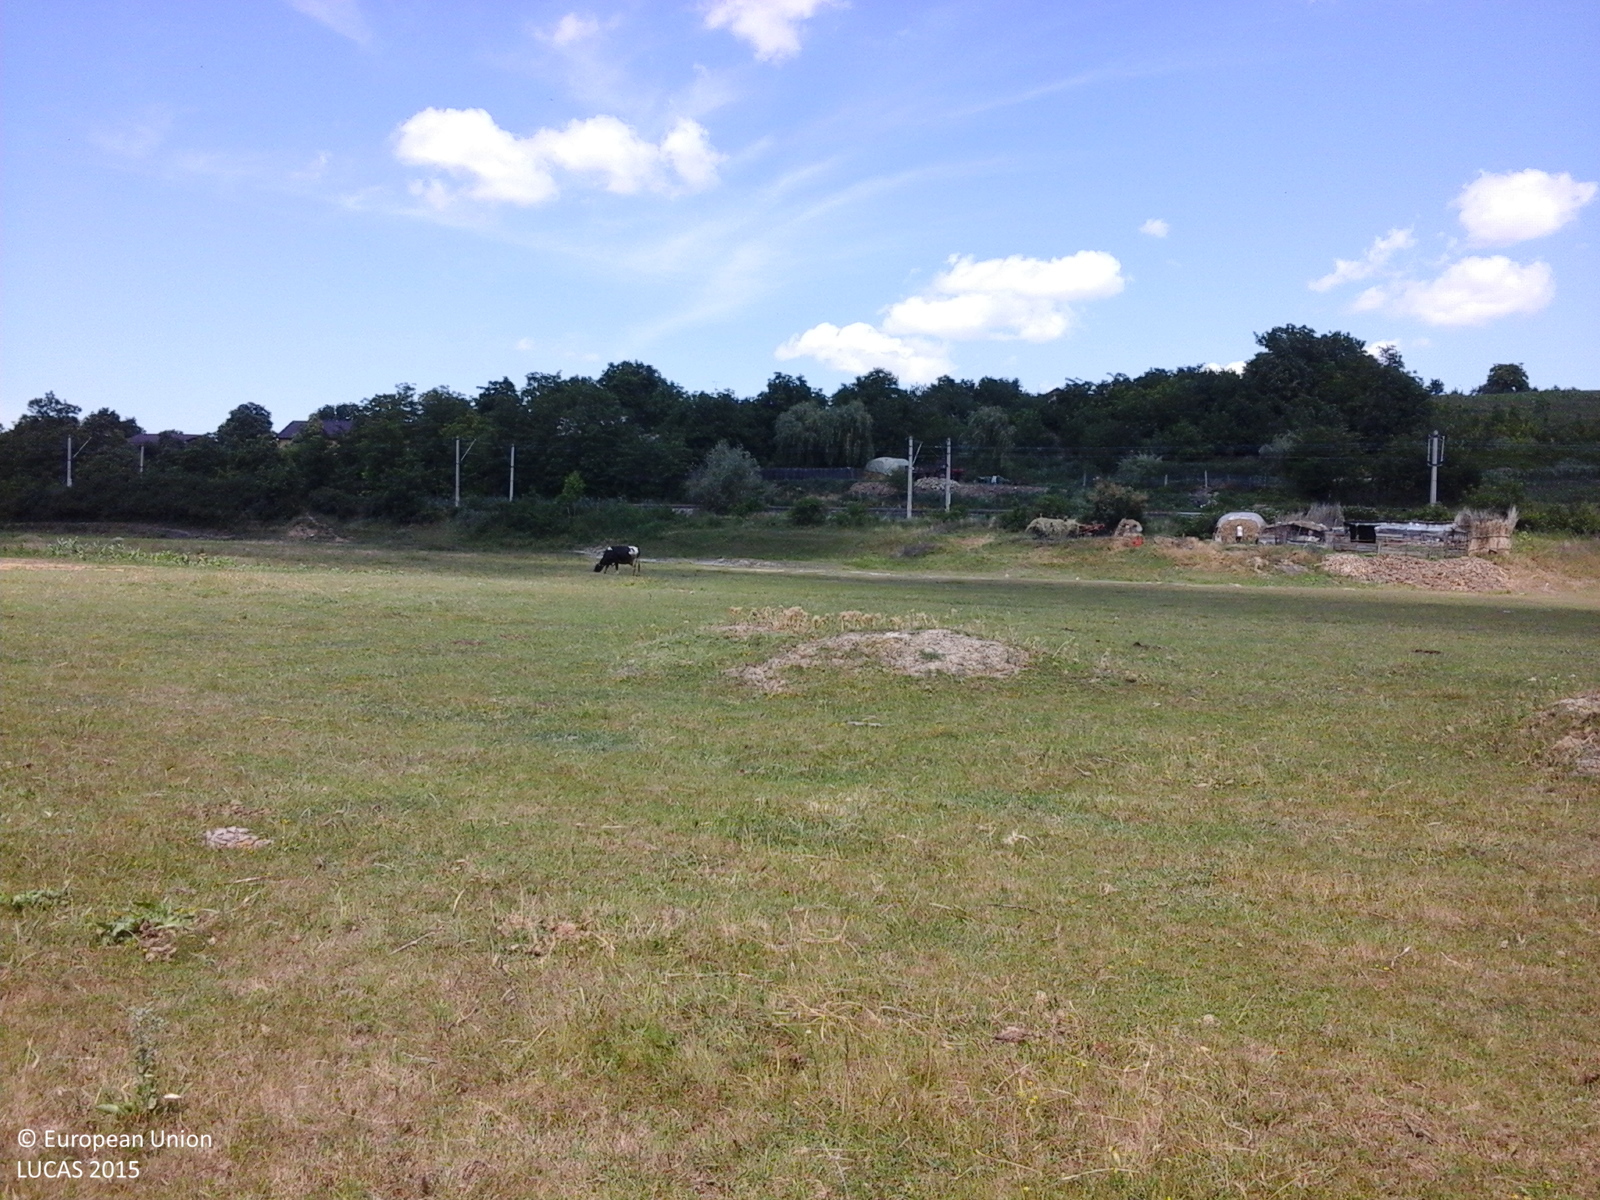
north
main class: Grassland
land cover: Grassland without tree/shrub cover
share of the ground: > 75 %
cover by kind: herbaceous plants 100 %
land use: Agriculture (excluding fallow land and kitchen gardens)
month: June
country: RO
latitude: 47.2142
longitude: 27.0430
